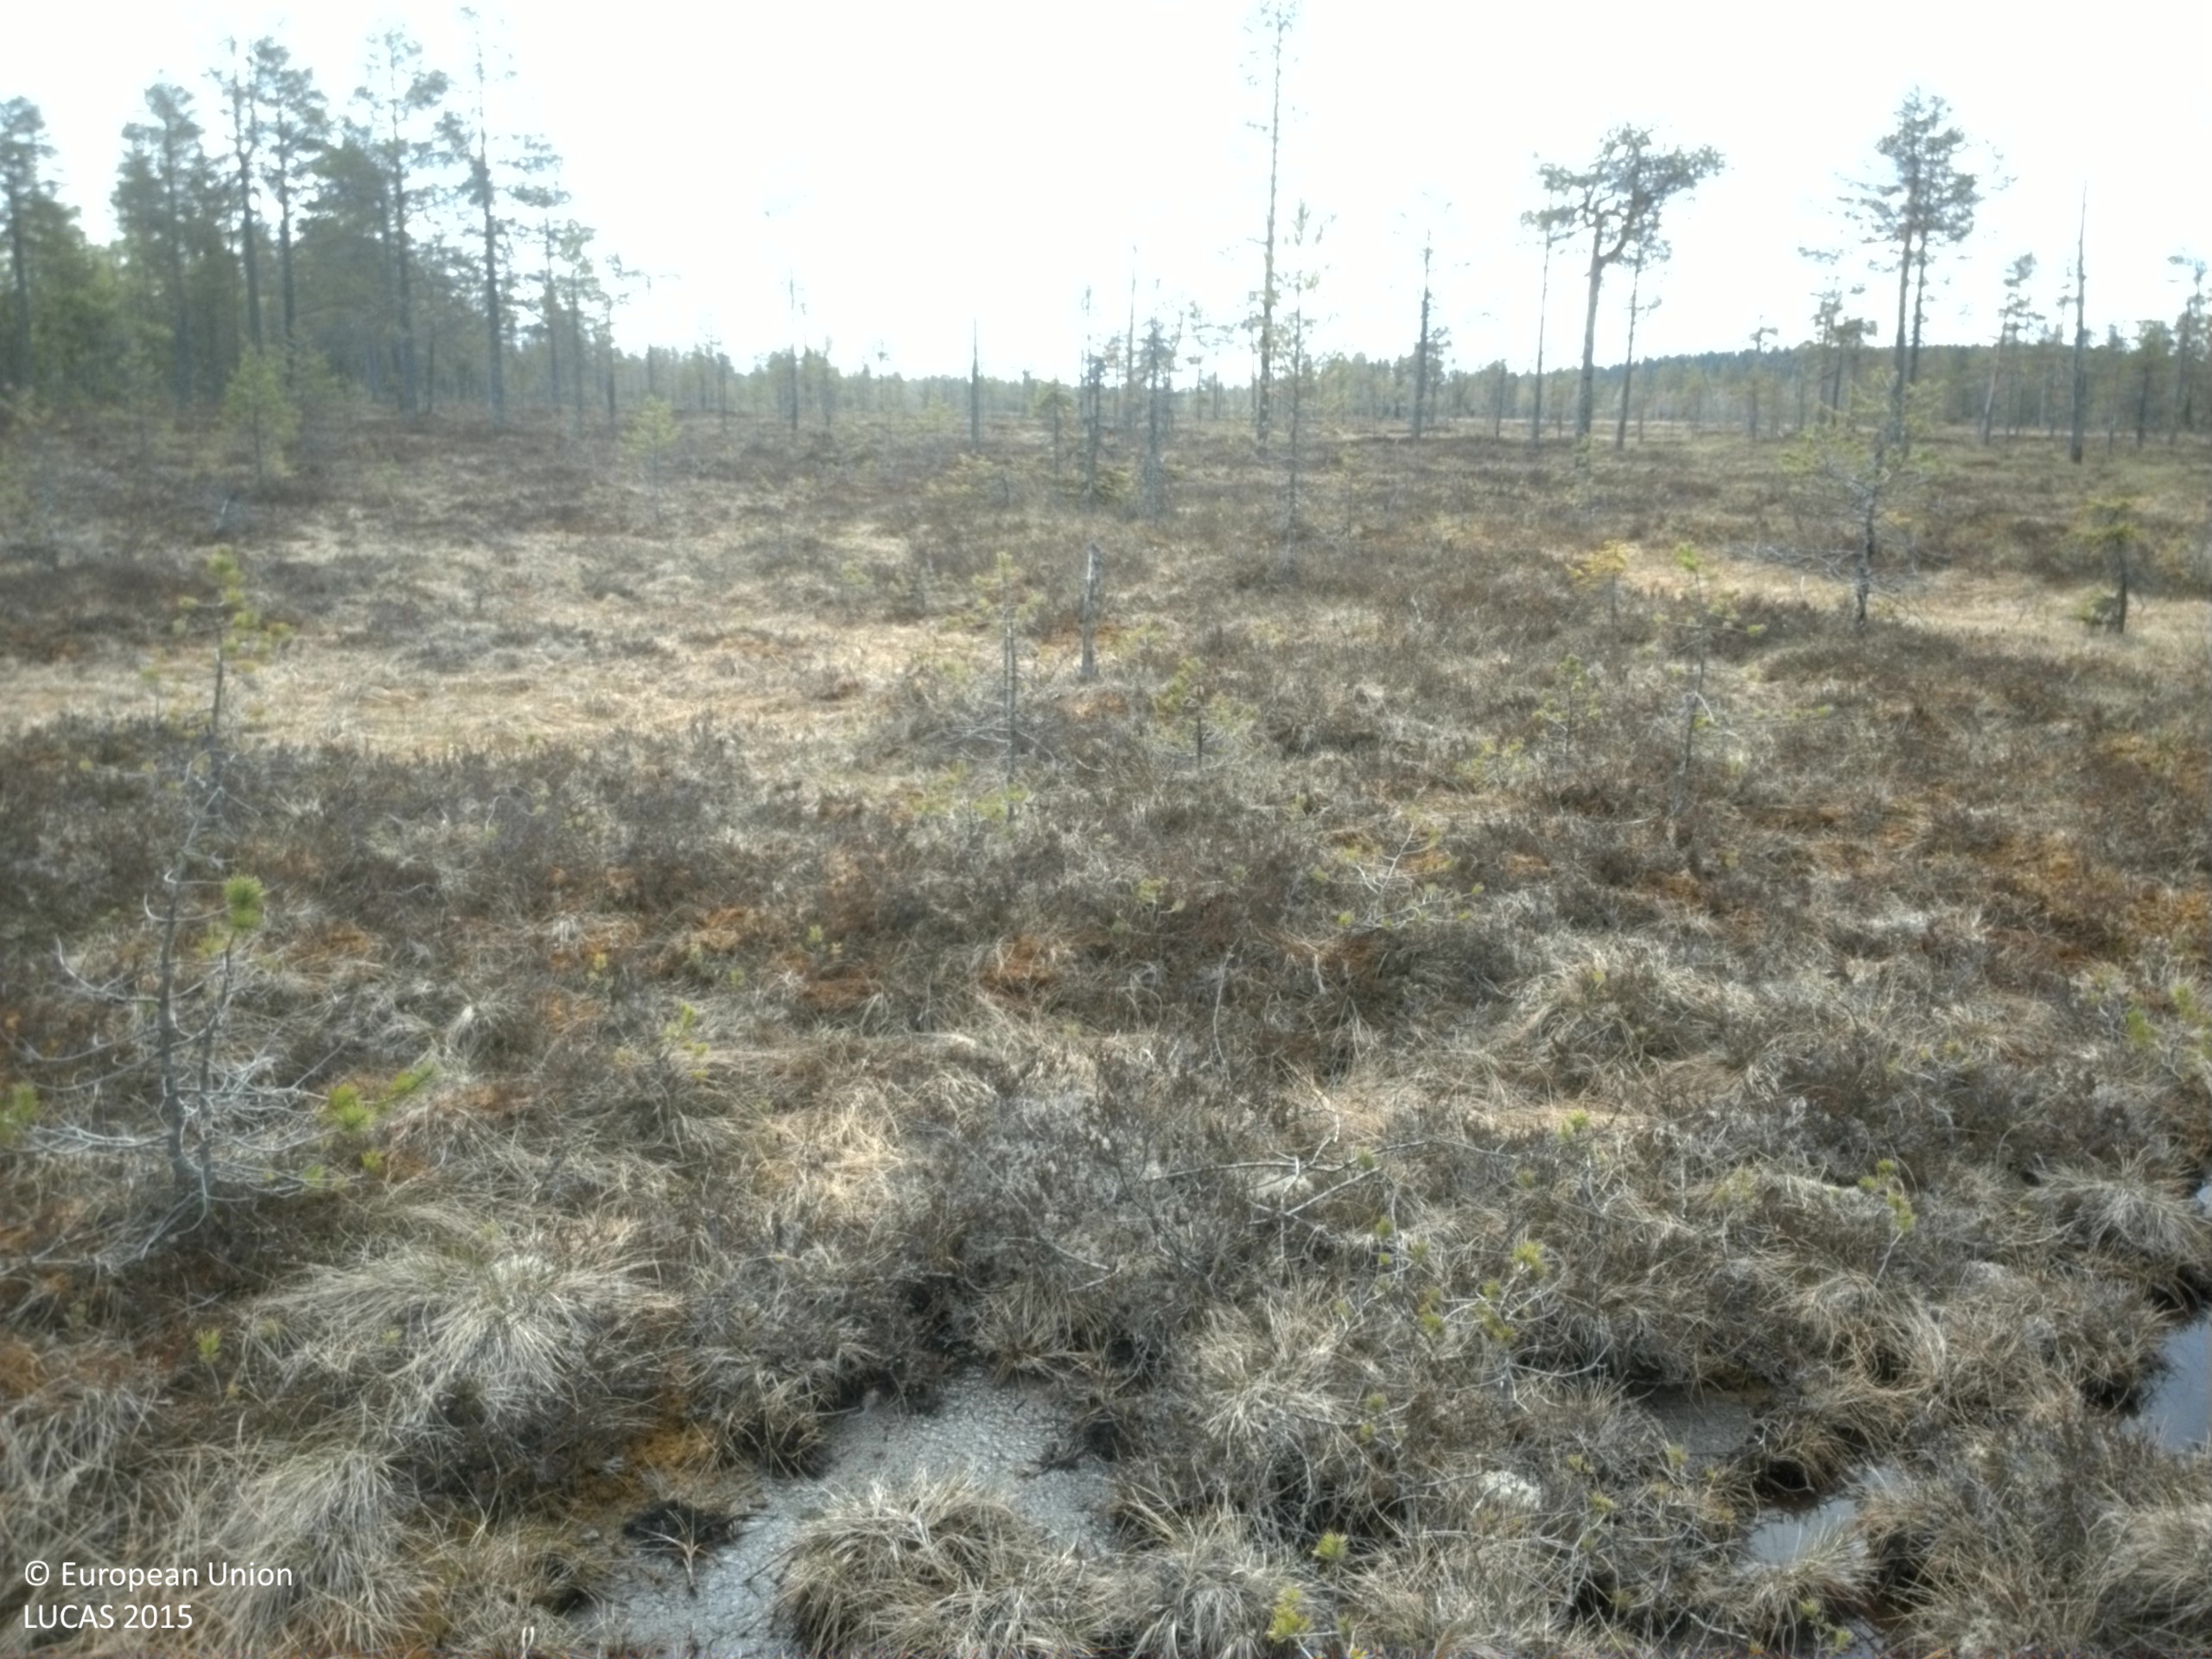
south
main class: Shrubland
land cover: Shrubland with sparse tree cover
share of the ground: 50 - 75 %
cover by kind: shrubs 70 %, herbaceous plants 25 %, coniferous forest trees 5 %
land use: Semi-natural and natural areas not in use
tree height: > 5 m
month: June
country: SE
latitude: 62.9147
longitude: 17.1233
